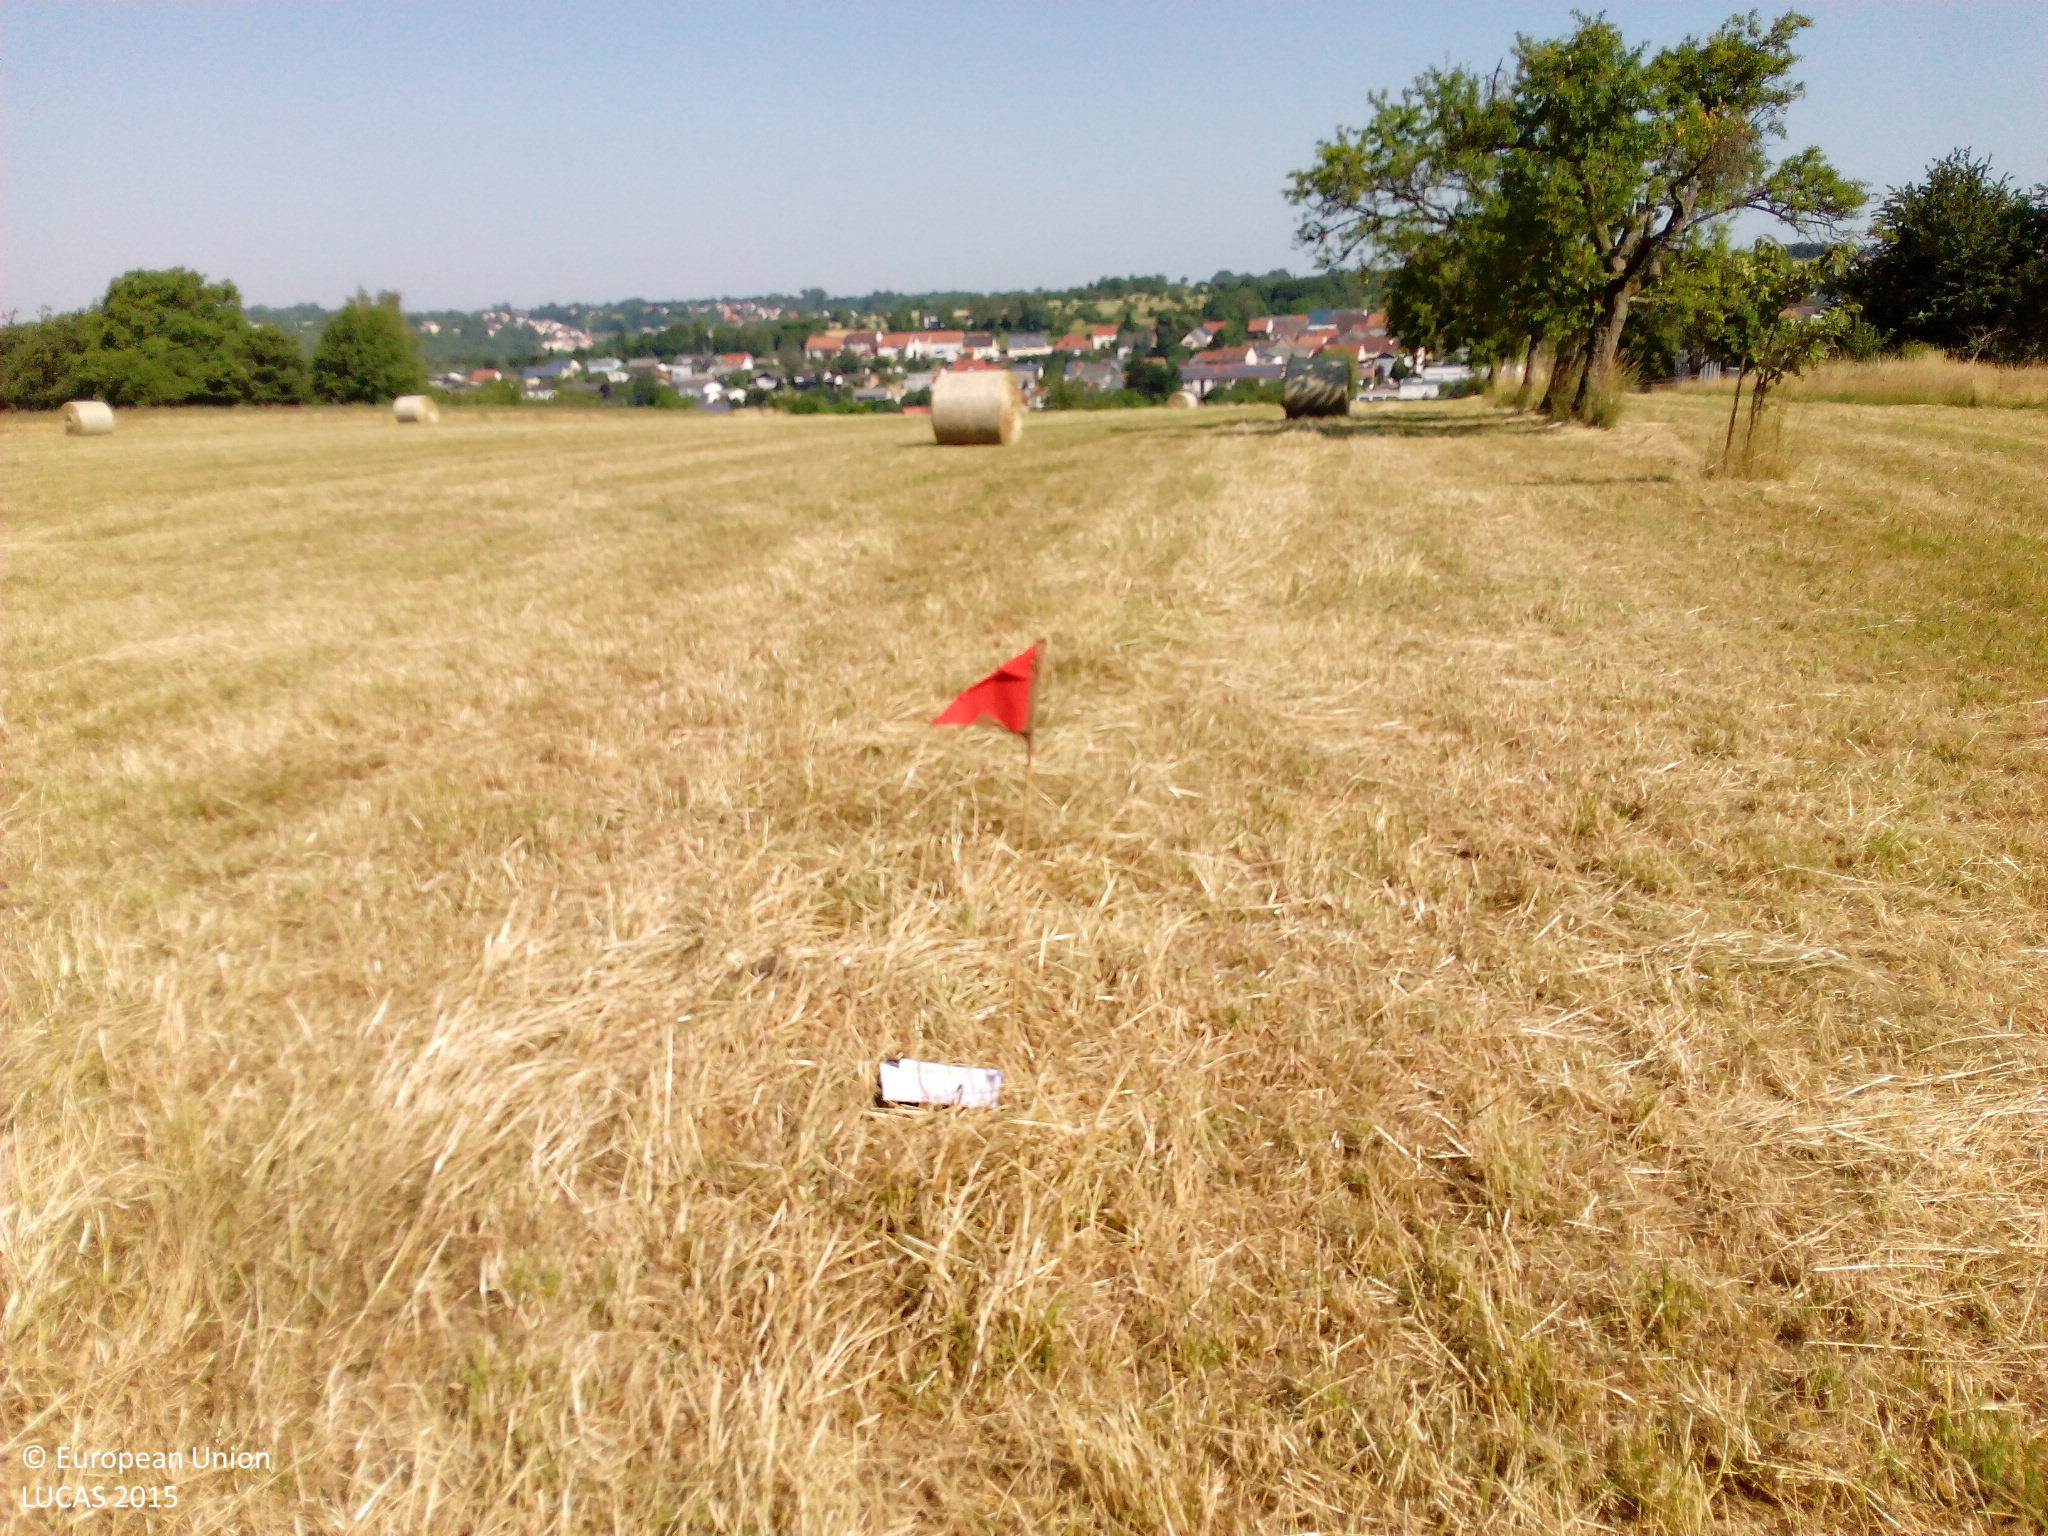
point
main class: Grassland
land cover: Grassland without tree/shrub cover
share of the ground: > 75 %
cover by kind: herbaceous plants 100 %
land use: Agriculture (excluding fallow land and kitchen gardens)
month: July
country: DE
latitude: 49.2131
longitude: 7.1588
